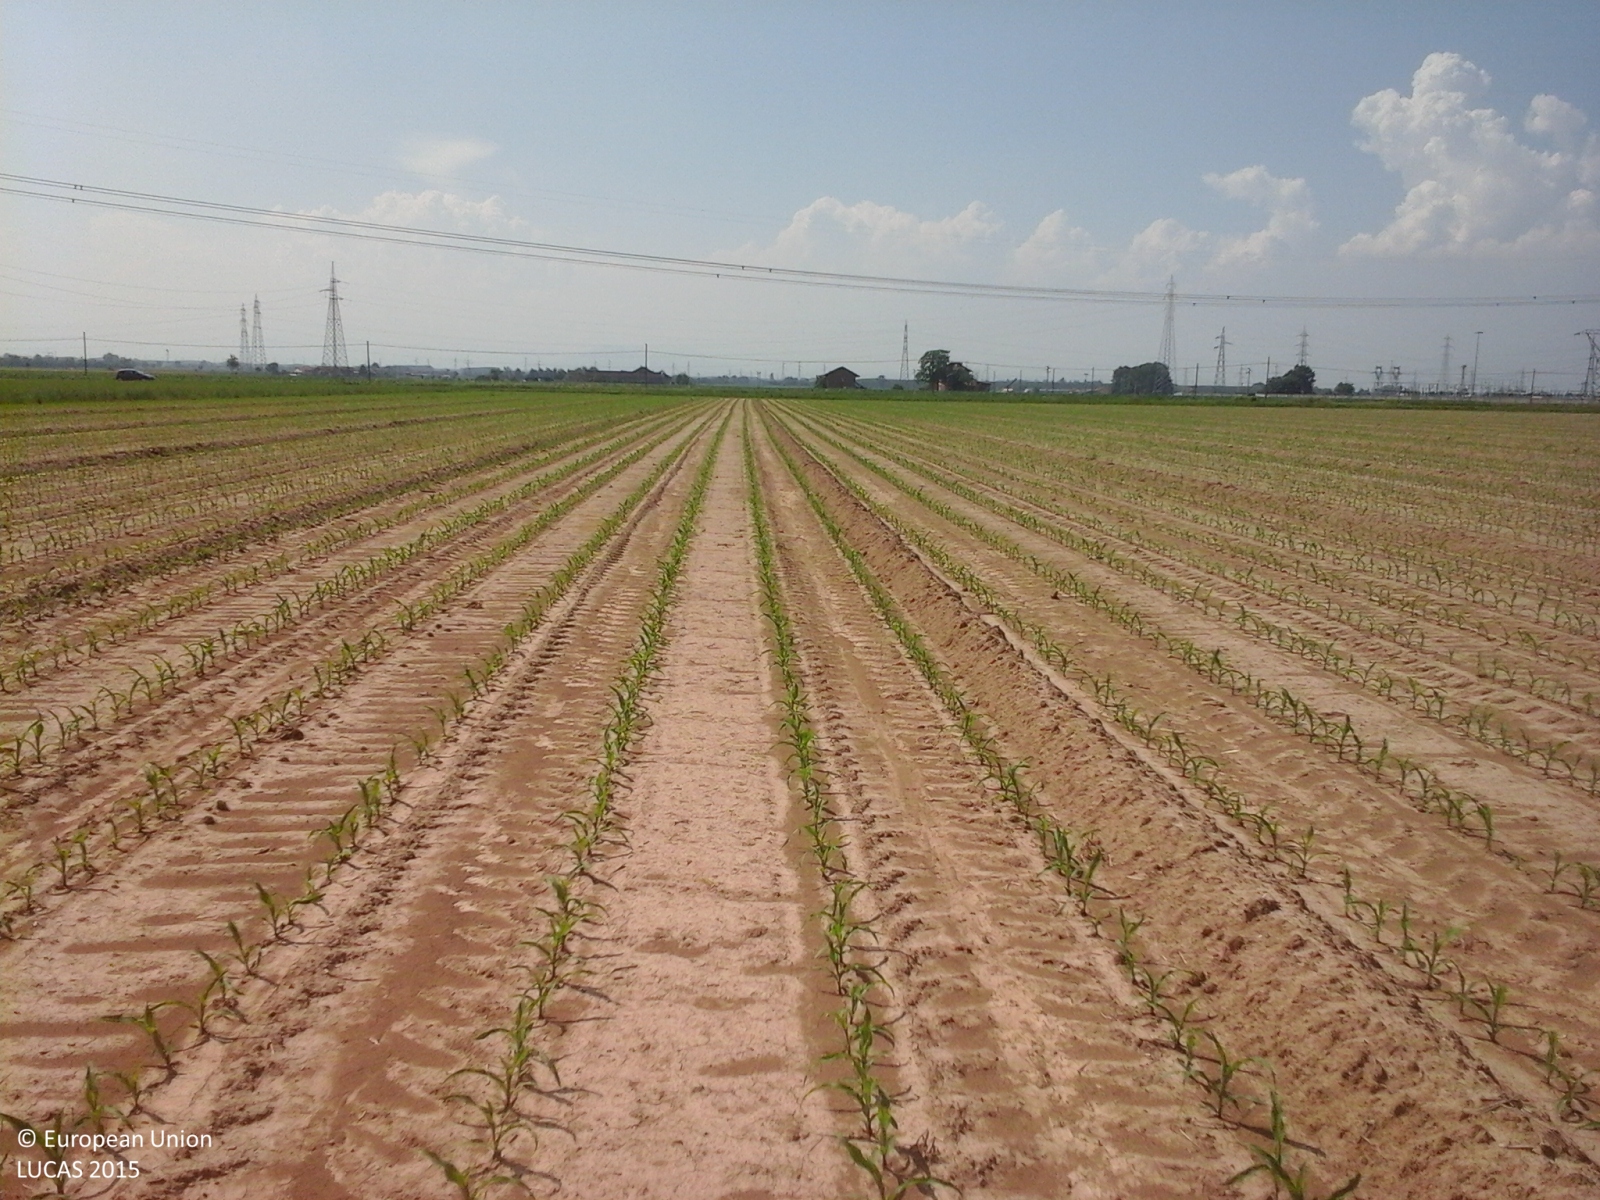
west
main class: Cropland
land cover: Maize
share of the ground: < 10 %
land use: Agriculture (excluding fallow land and kitchen gardens)
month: June
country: IT
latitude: 44.8682
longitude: 7.7892
